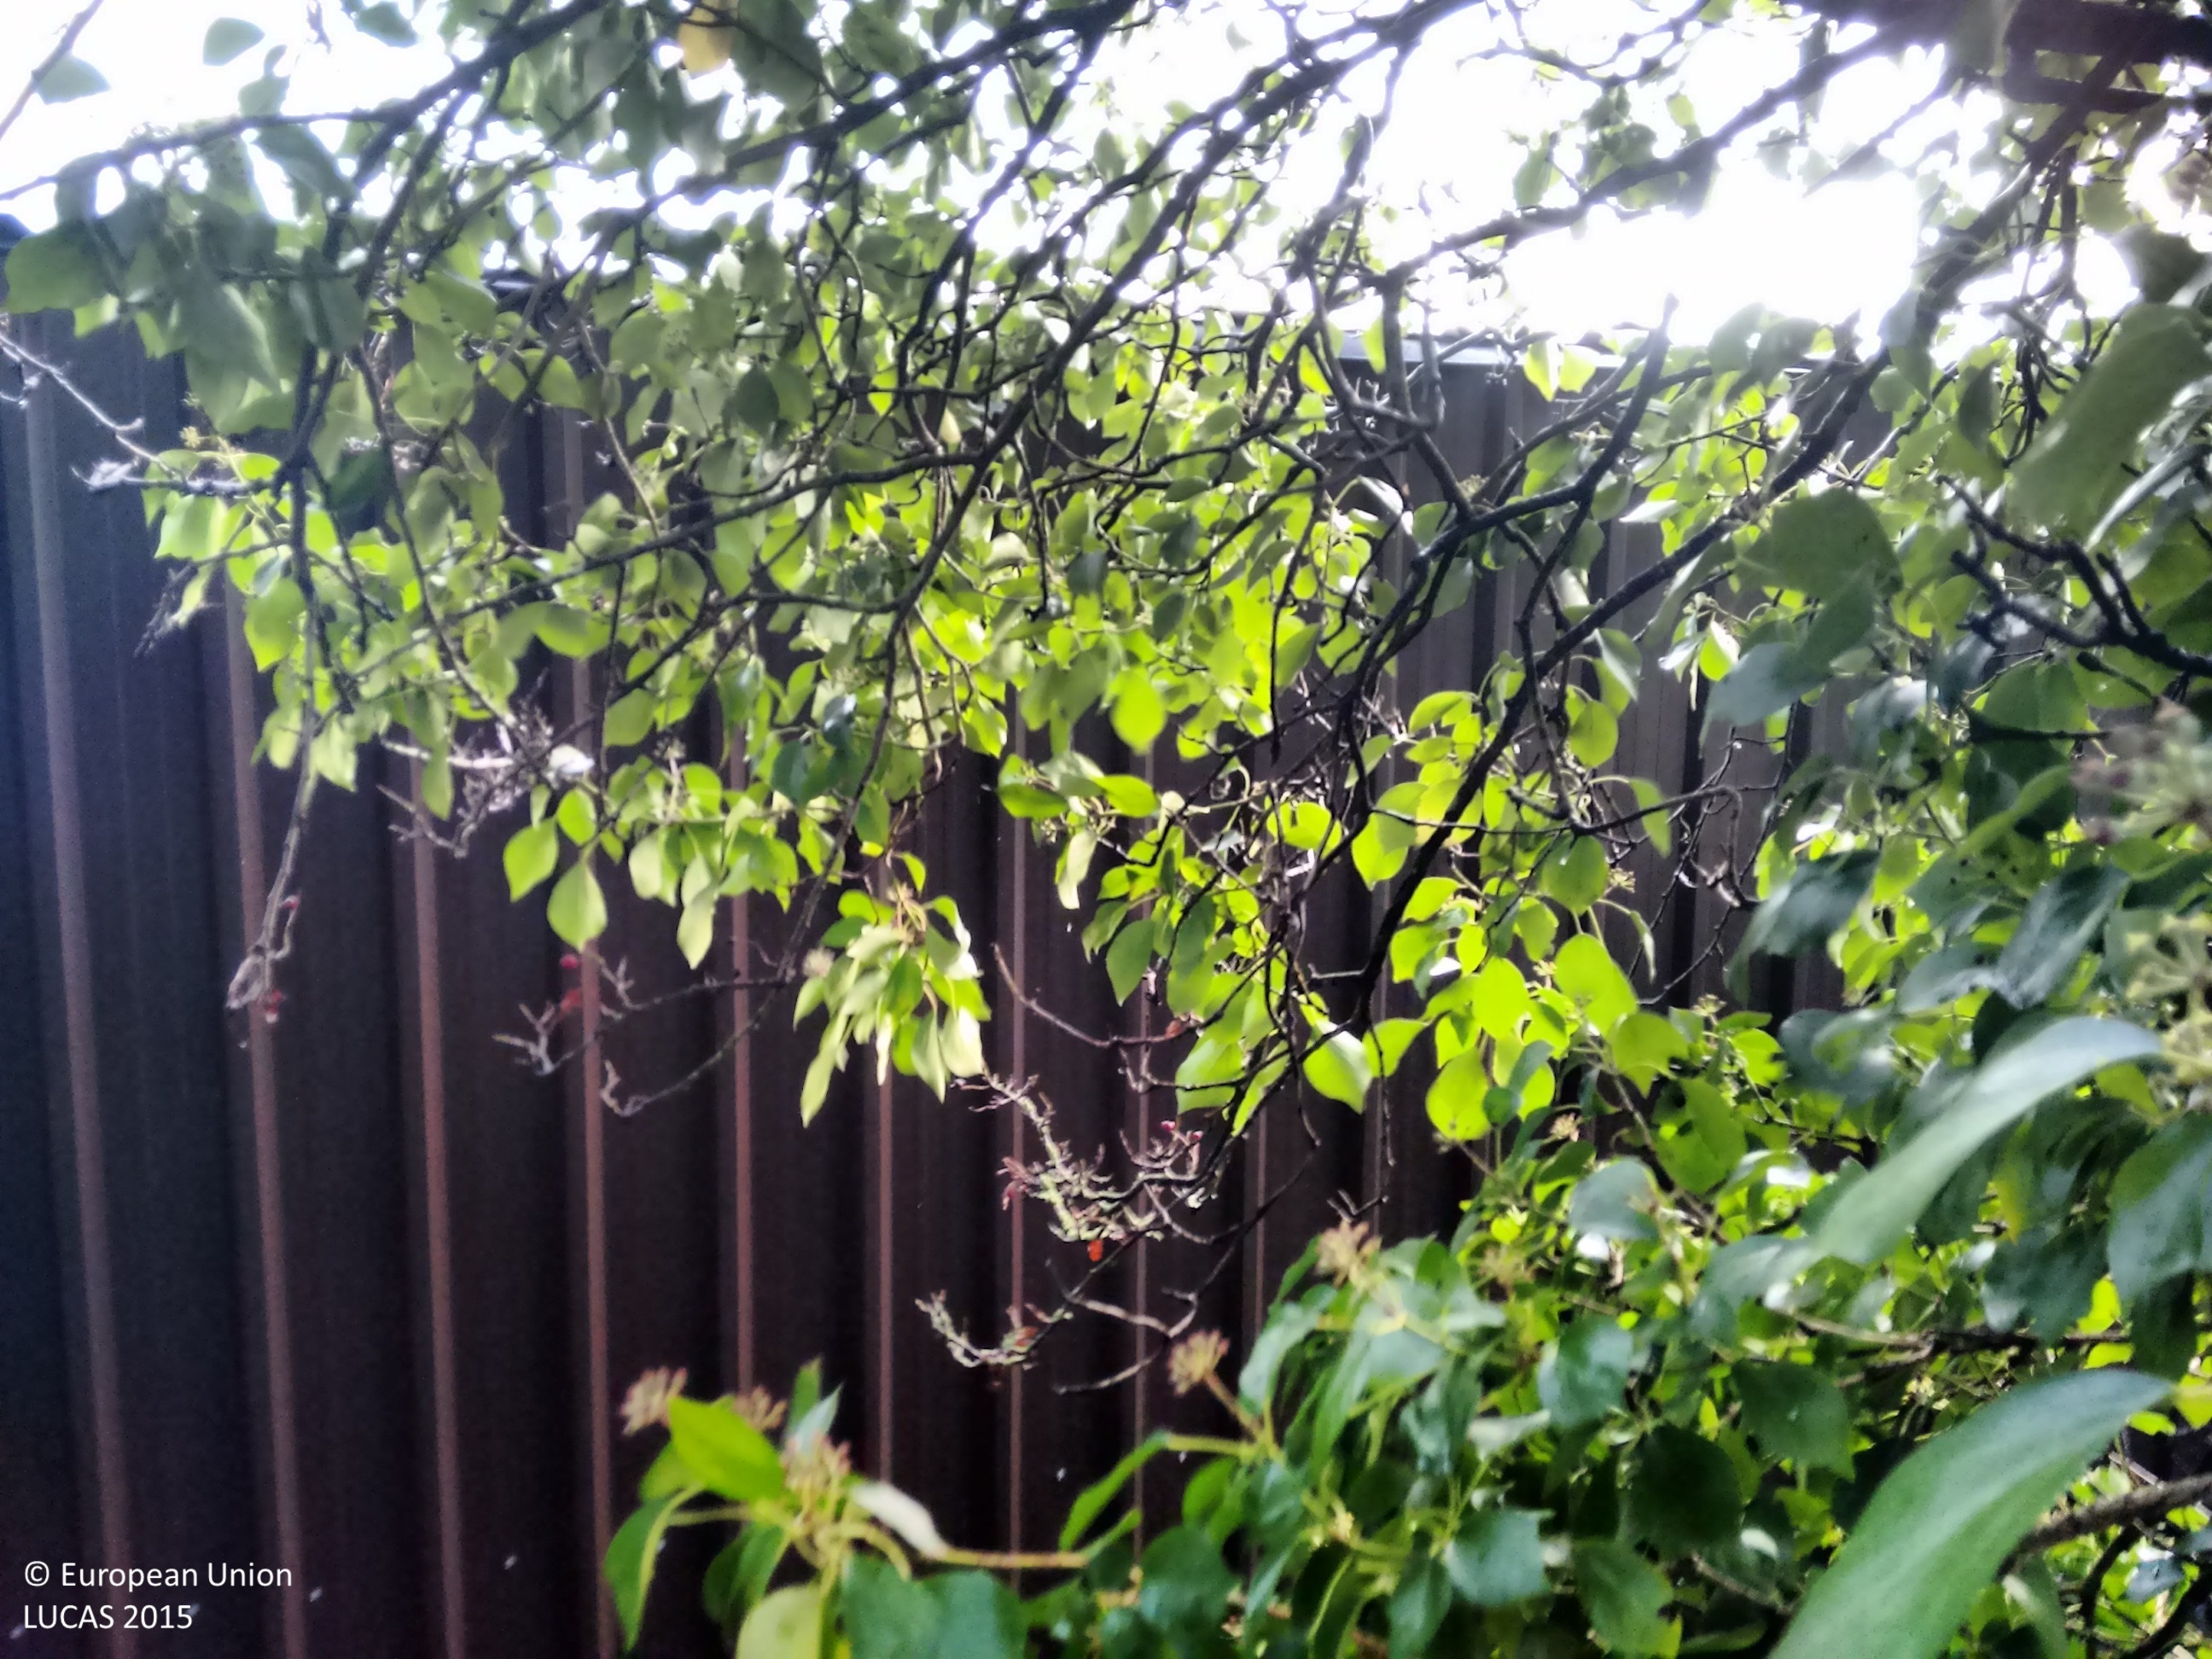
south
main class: Grassland
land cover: Grassland without tree/shrub cover
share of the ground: > 75 %
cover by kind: herbaceous plants 100 %
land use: Agriculture (excluding fallow land and kitchen gardens)
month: November
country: IE
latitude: 53.9055
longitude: -7.9668
